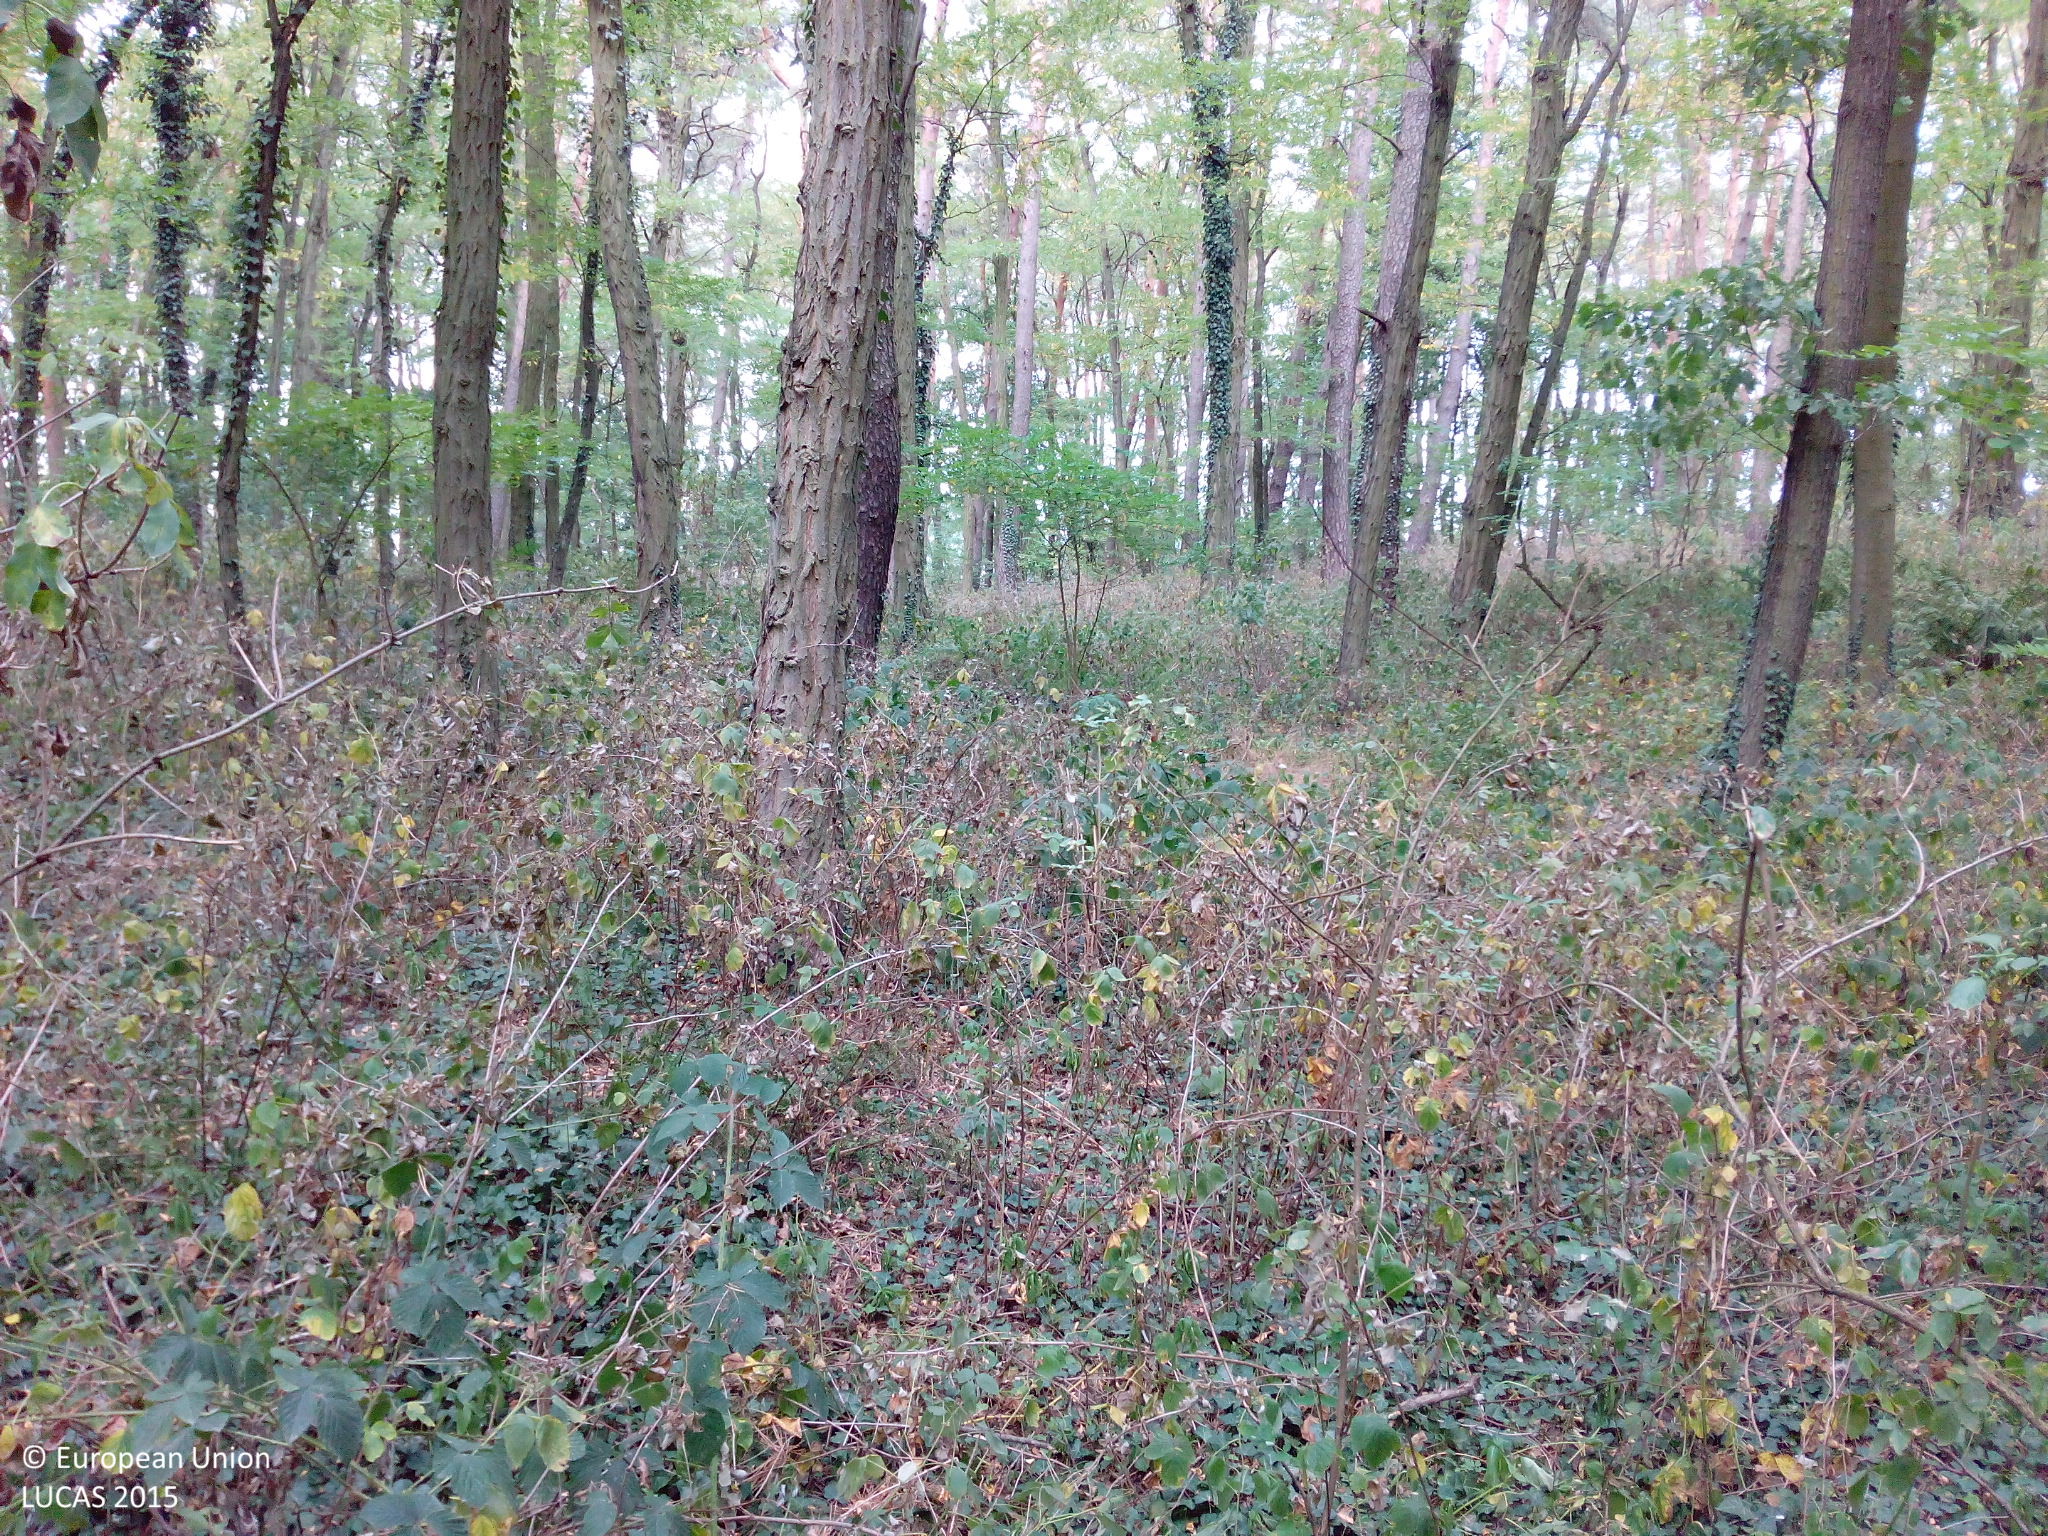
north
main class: Woodland
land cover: Pine dominated mixed woodland
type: hemiboreal forest and nemoral coniferous forest and mixed broadleaved-coniferous forest
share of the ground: > 75 %
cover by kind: coniferous forest trees 60 %, broadleaved forest trees 30 %, shrubs 5 %, herbaceous plants 5 %
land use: Forestry
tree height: > 5 m
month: August
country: DE
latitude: 52.4030
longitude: 14.4257
